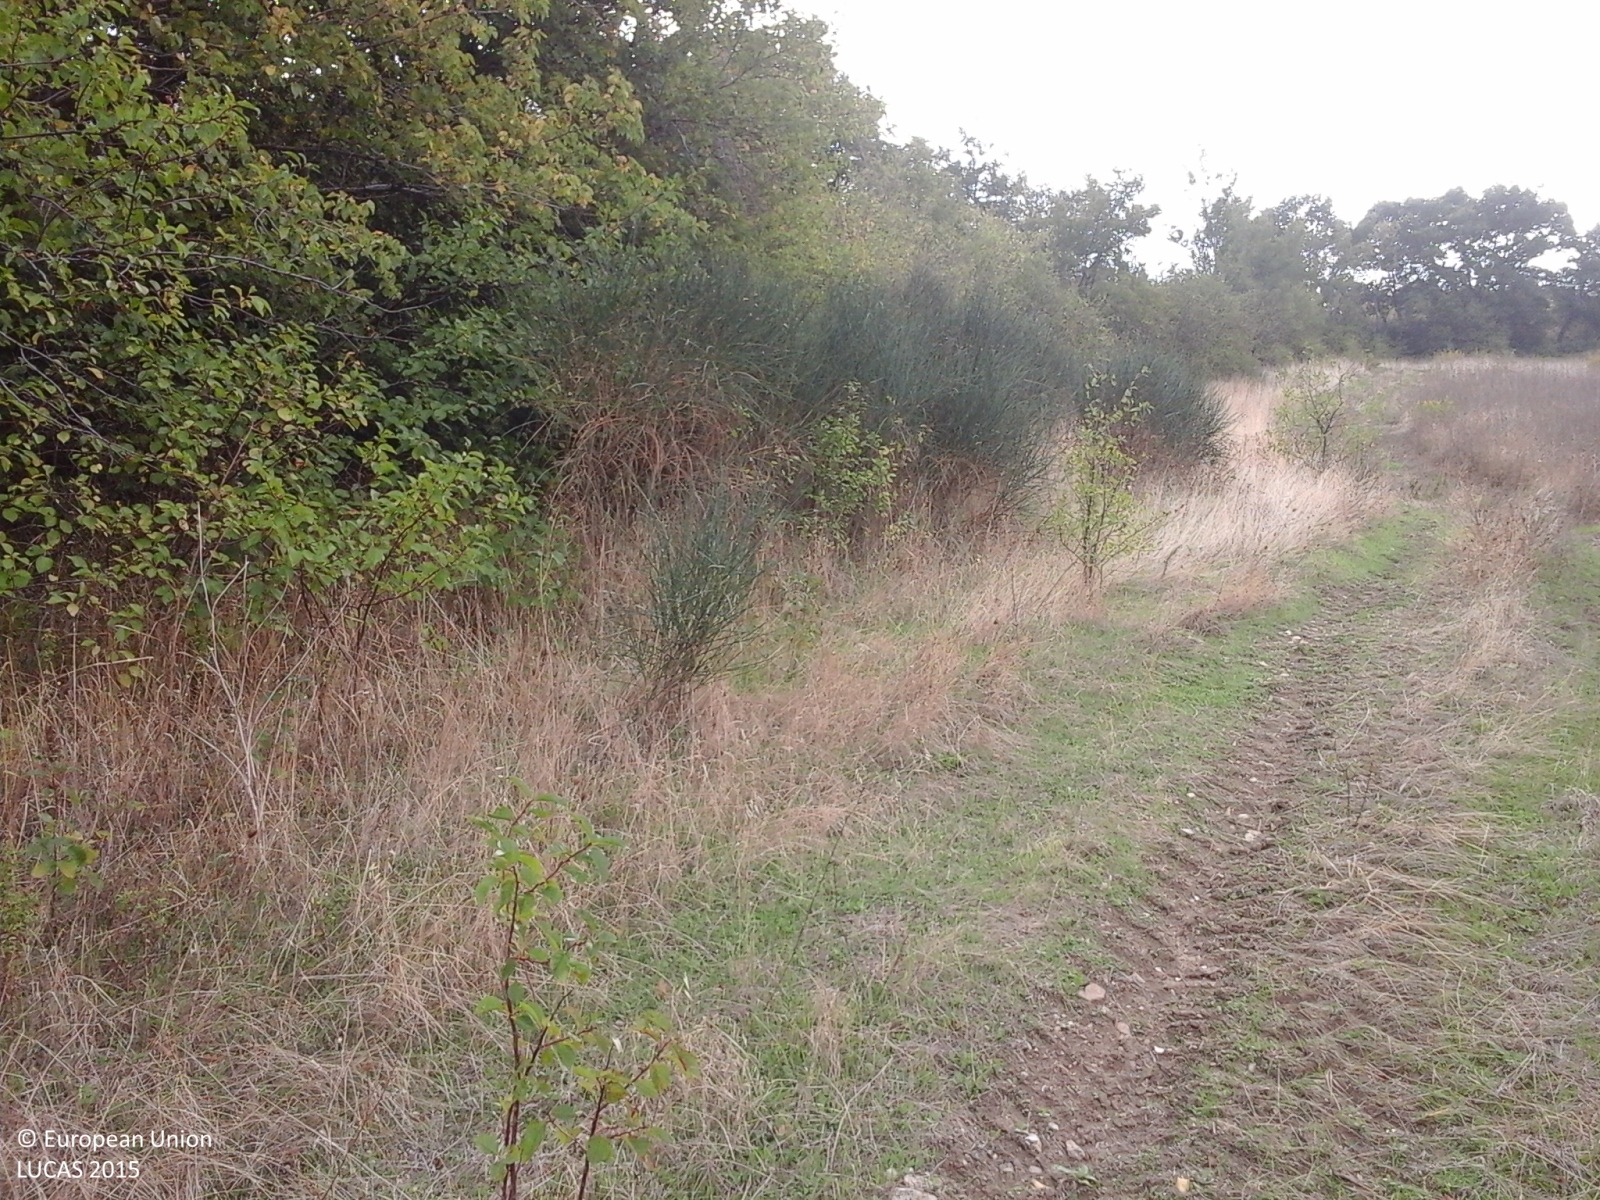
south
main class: Grassland
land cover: Spontaneously vegetated surfaces
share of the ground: > 75 %
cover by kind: herbaceous plants 100 %
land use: Fallow land
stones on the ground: < 10 %
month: October
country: IT
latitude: 41.5107
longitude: 15.1228
